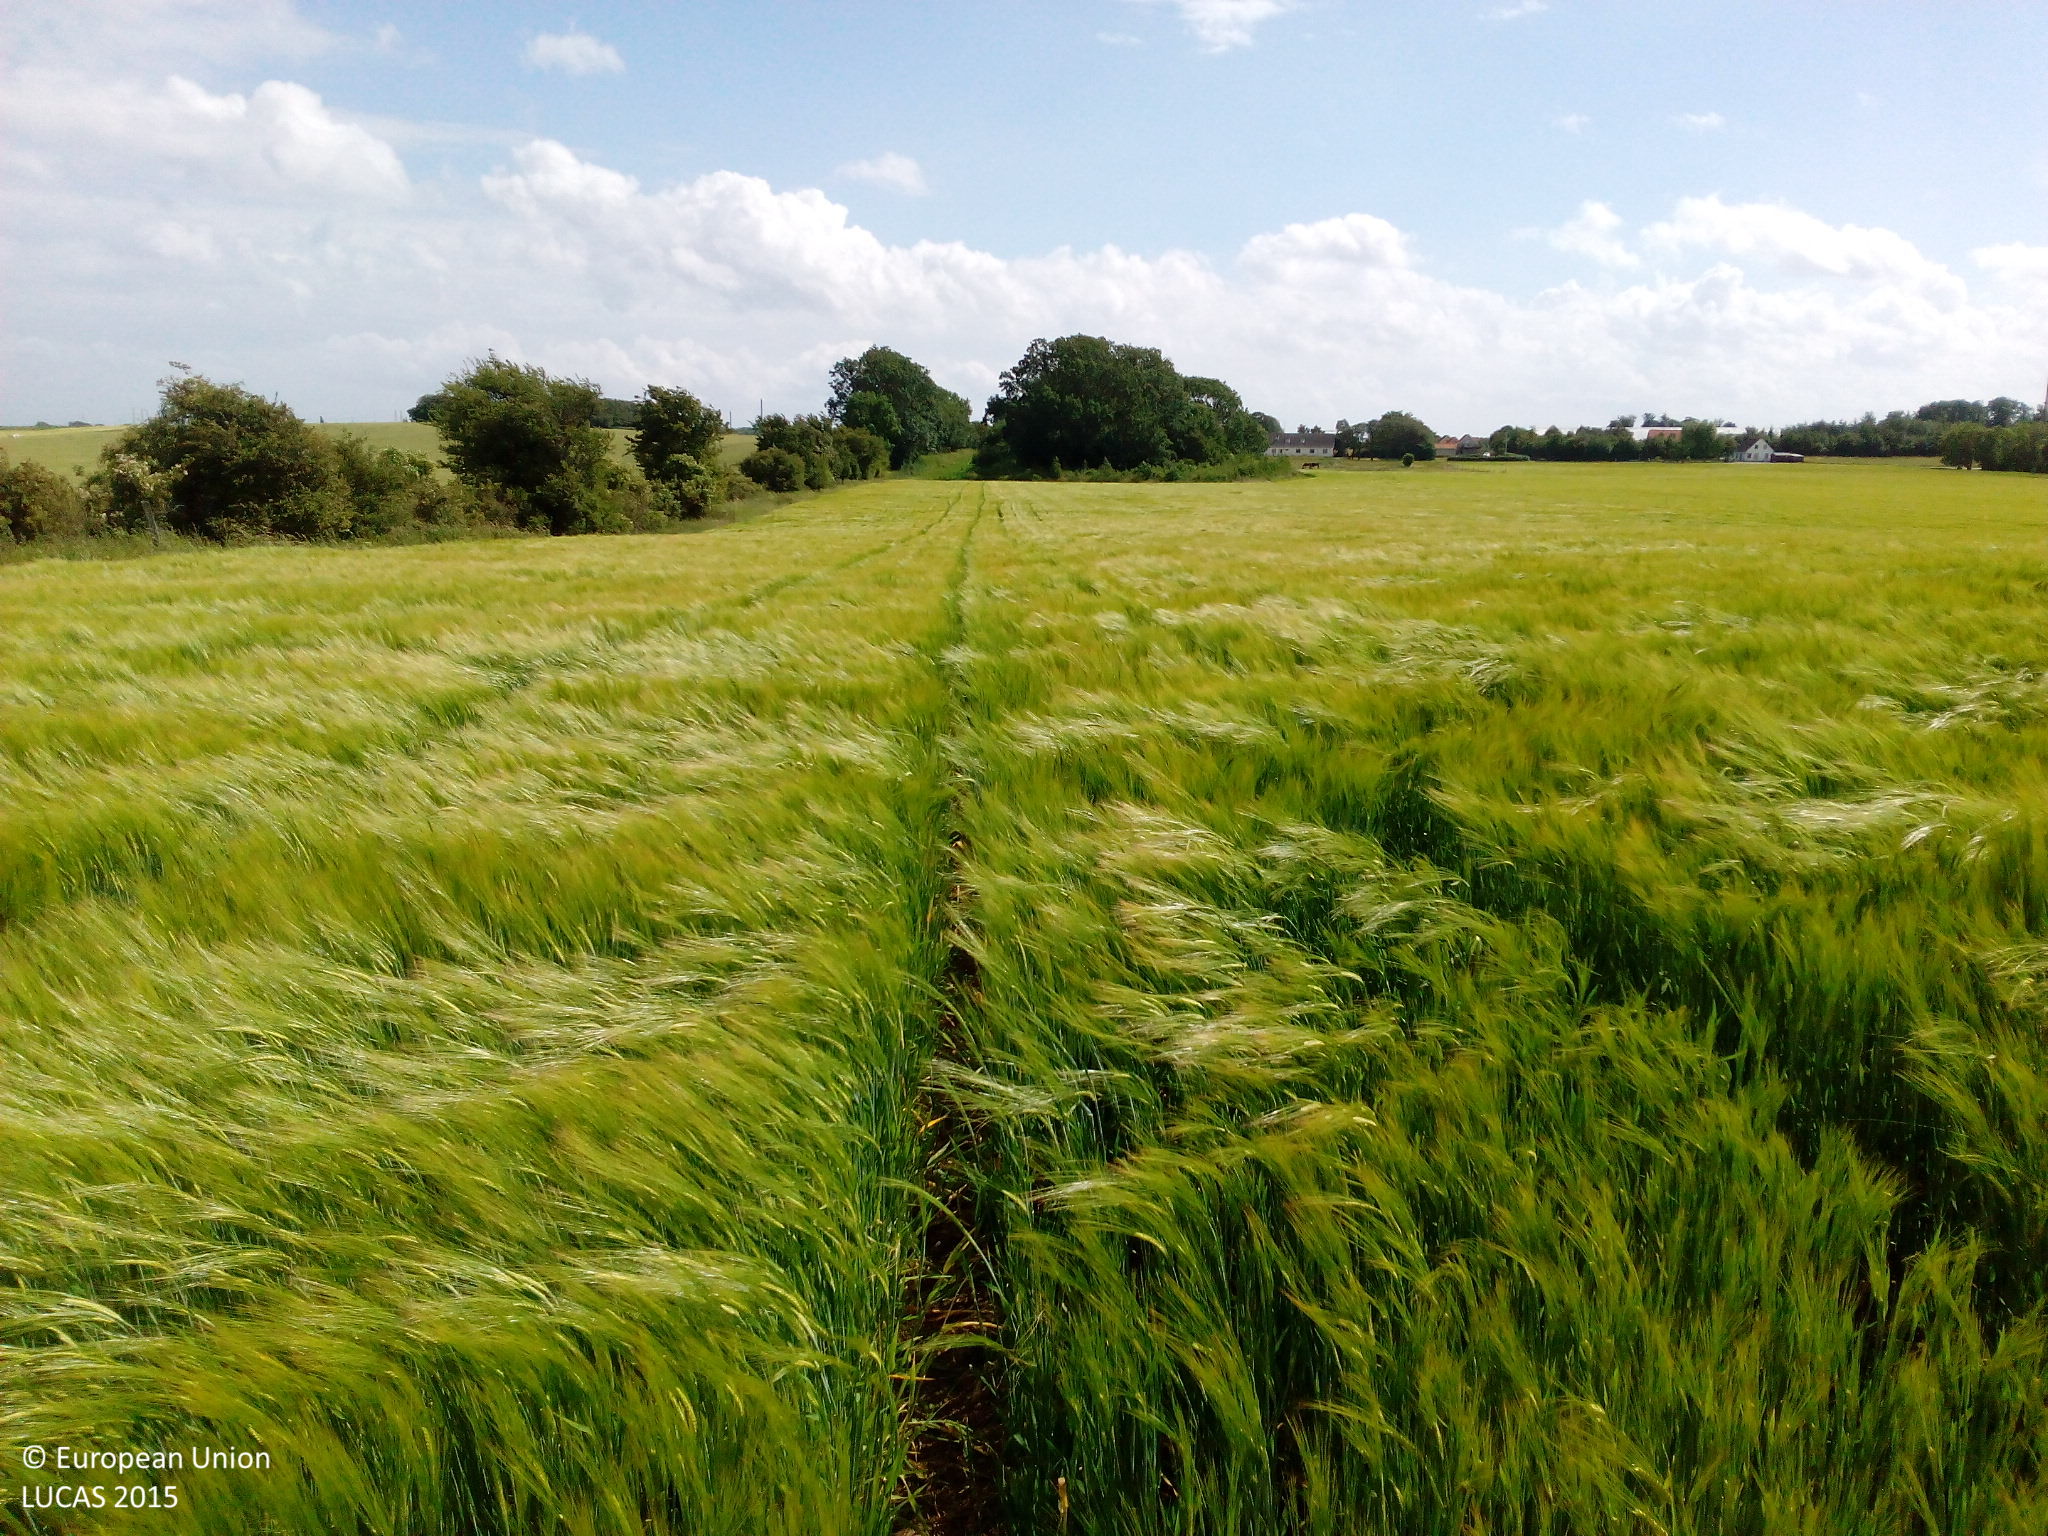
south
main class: Cropland
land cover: Barley
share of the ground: > 75 %
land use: Agriculture (excluding fallow land and kitchen gardens)
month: July
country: DK
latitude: 55.2287
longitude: 11.2725
